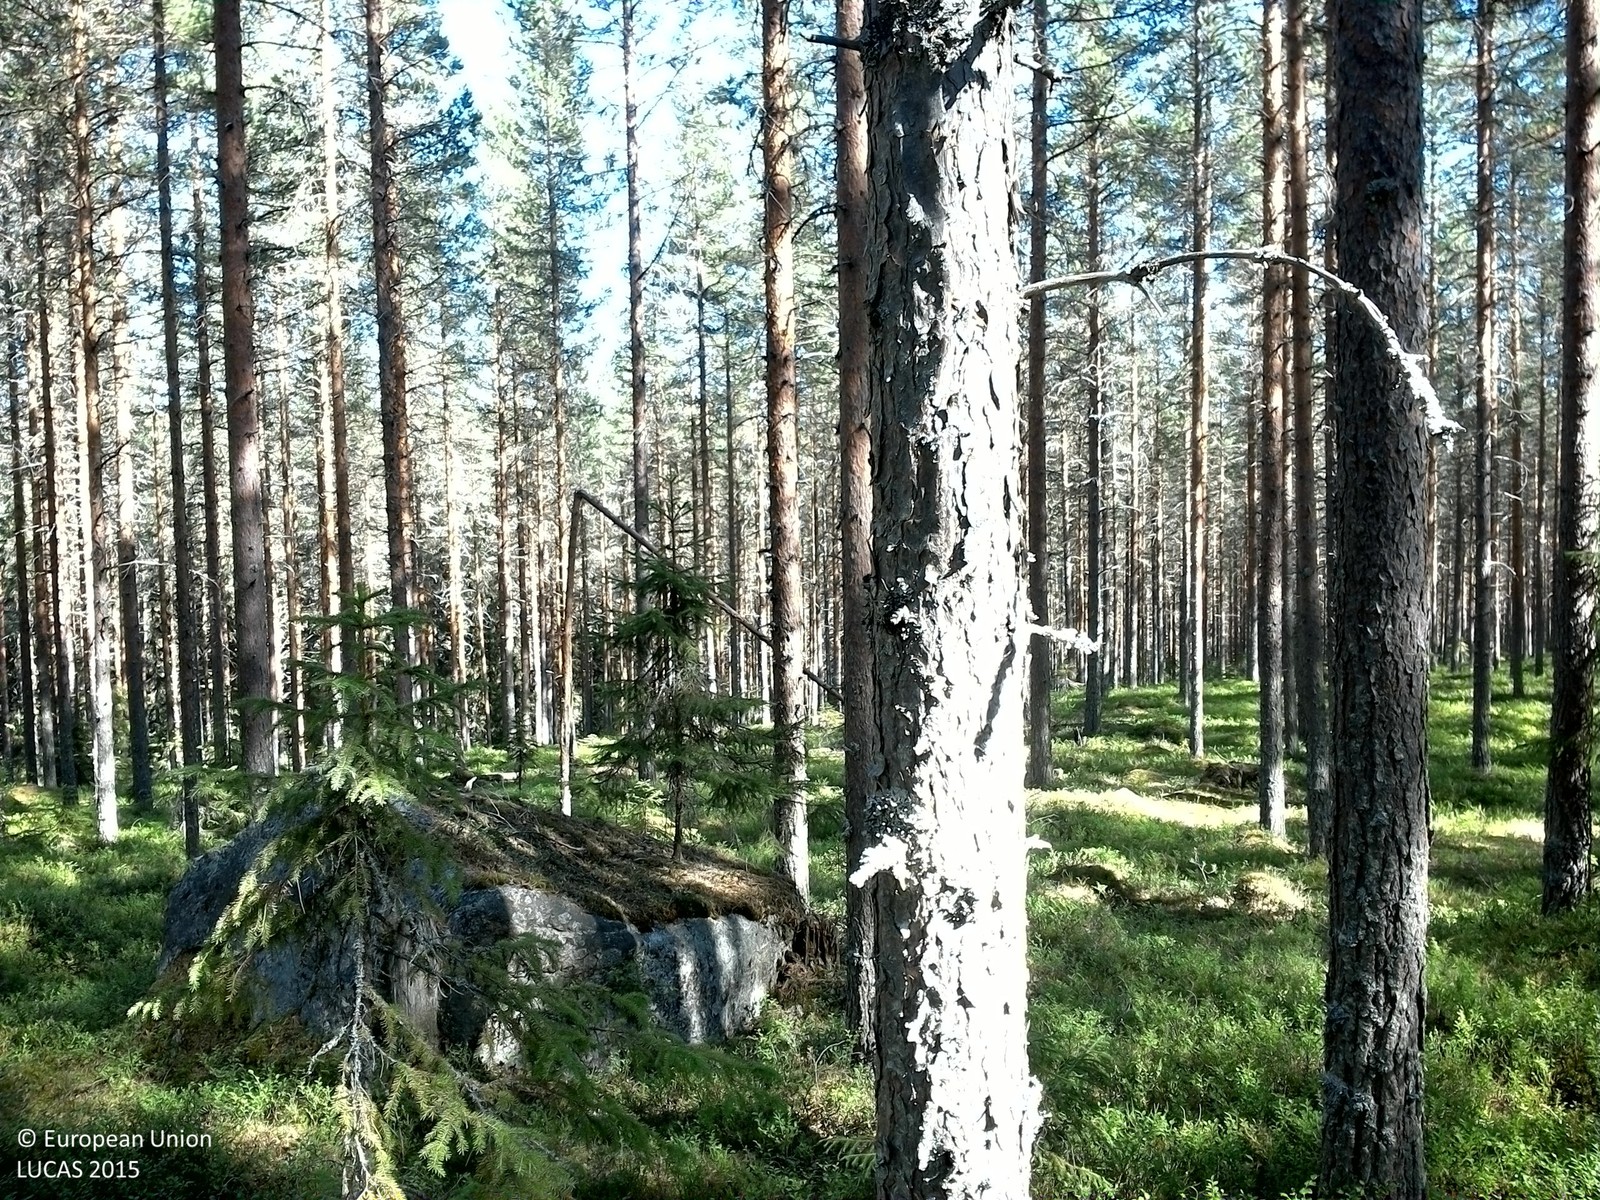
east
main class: Woodland
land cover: Pine dominated coniferous woodland
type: boreal forest
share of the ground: 50 - 75 %
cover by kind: coniferous forest trees 65 %, shrubs 30 %, herbaceous plants 5 %
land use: Forestry
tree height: > 5 m
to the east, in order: Pine dominated coniferous woodland; Spruce dominated coniferous woodland; Ditches and canals; Spruce dominated coniferous woodland; Pine dominated coniferous woodland
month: August
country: SE
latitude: 63.5962
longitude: 18.0162
